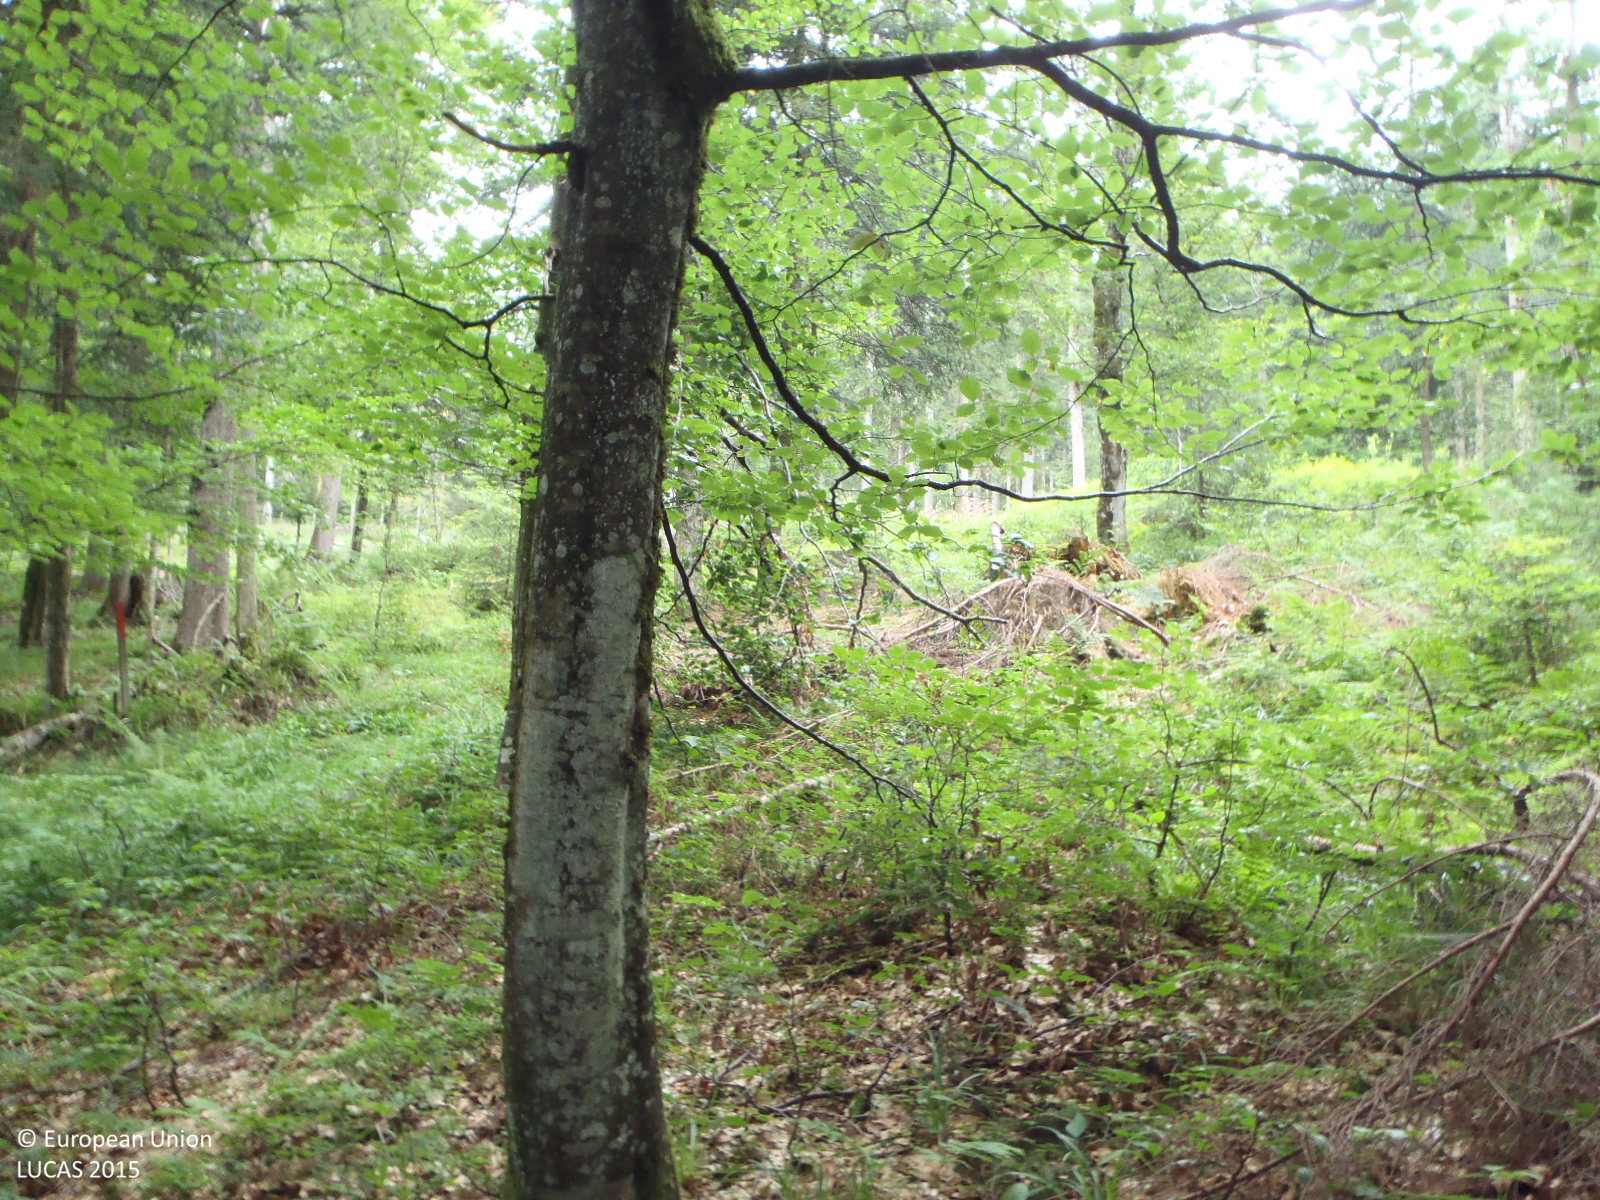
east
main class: Woodland
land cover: Spruce dominated mixed woodland
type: alpine coniferous forest
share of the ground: > 75 %
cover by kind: coniferous forest trees 55 %, broadleaved forest trees 30 %, herbaceous plants 10 %, unconsolidated bare surface 5 %
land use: Forestry
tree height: > 5 m
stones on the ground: < 10 %
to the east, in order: Spruce dominated mixed woodland; Tracks; Spruce dominated mixed woodland; Other mixed woodland; Tracks; Spruce dominated mixed woodland; Rivers and streams; Spruce dominated mixed woodland; Grassland with sparse tree/shrub cover; Other mixed woodland
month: July
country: AT
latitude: 47.5036
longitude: 9.9867
